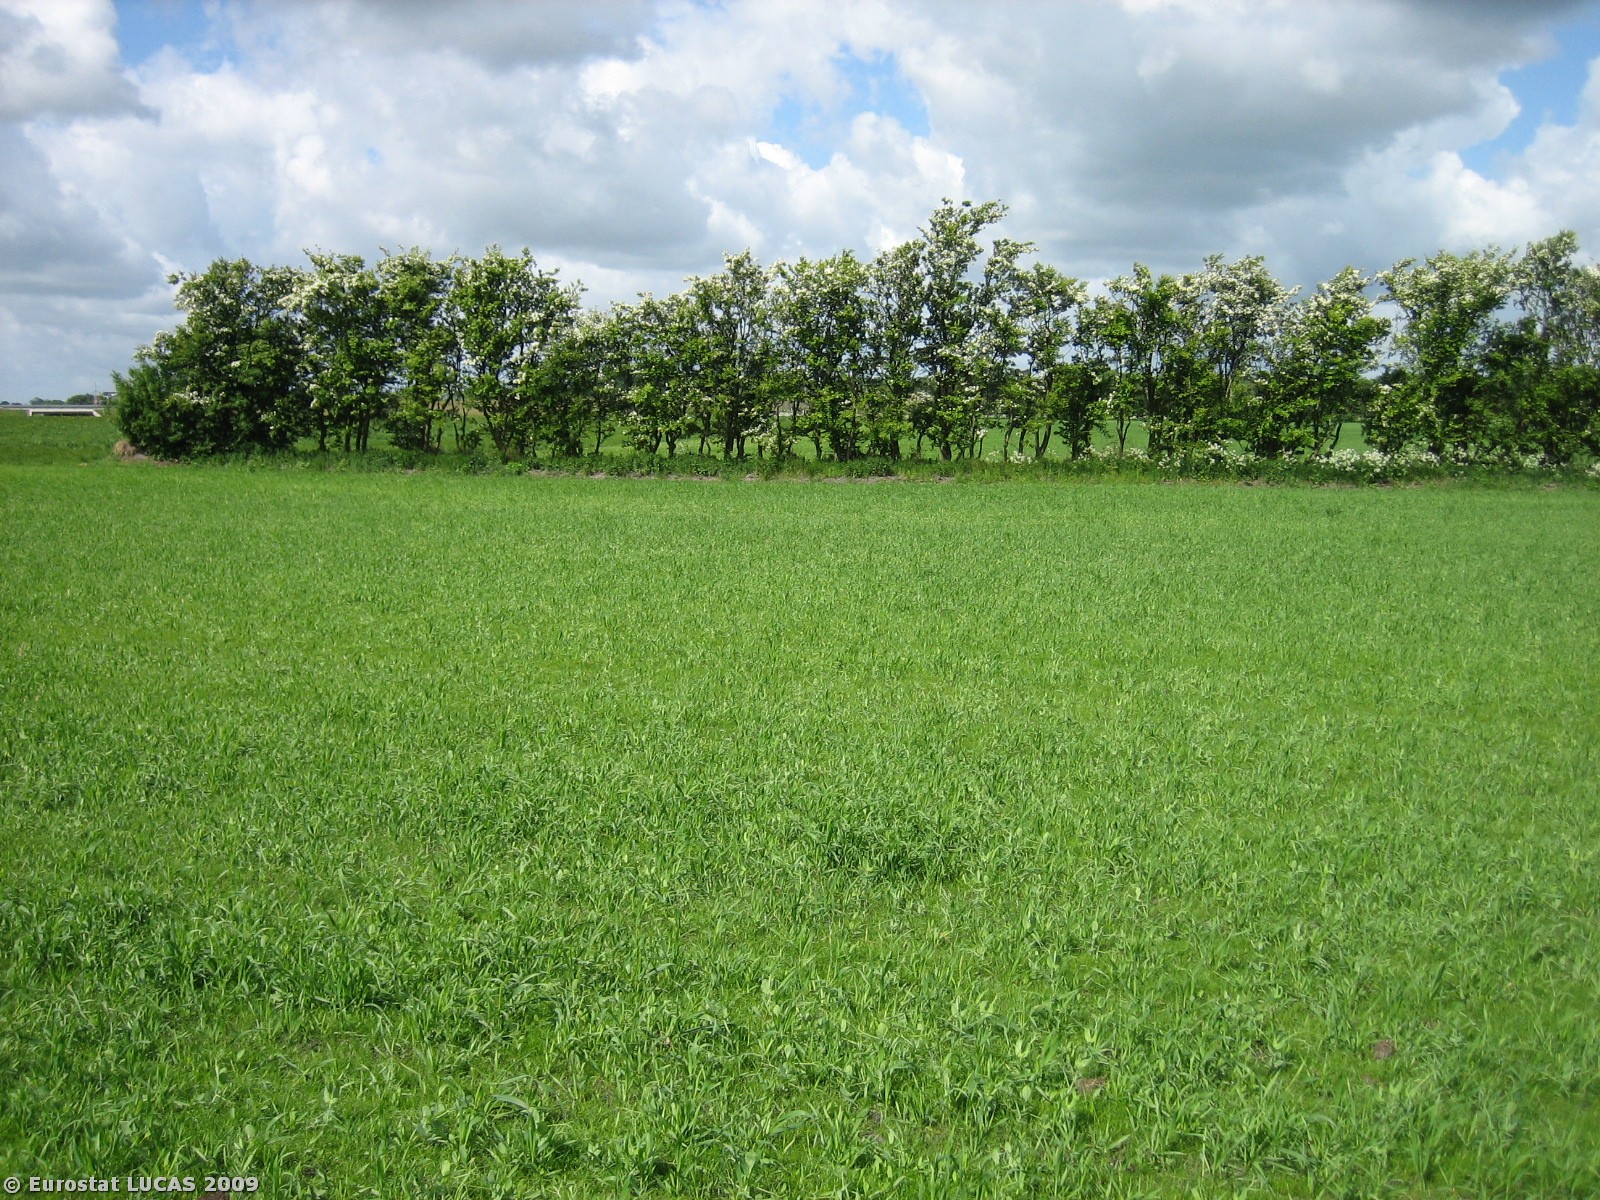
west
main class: Cropland
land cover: Rye
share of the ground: 25 - 50 %
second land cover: Dry pulses
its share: 10 - 25 %
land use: Agriculture (excluding fallow land and kitchen gardens)
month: May
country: DK
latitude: 55.8442
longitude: 9.2821
